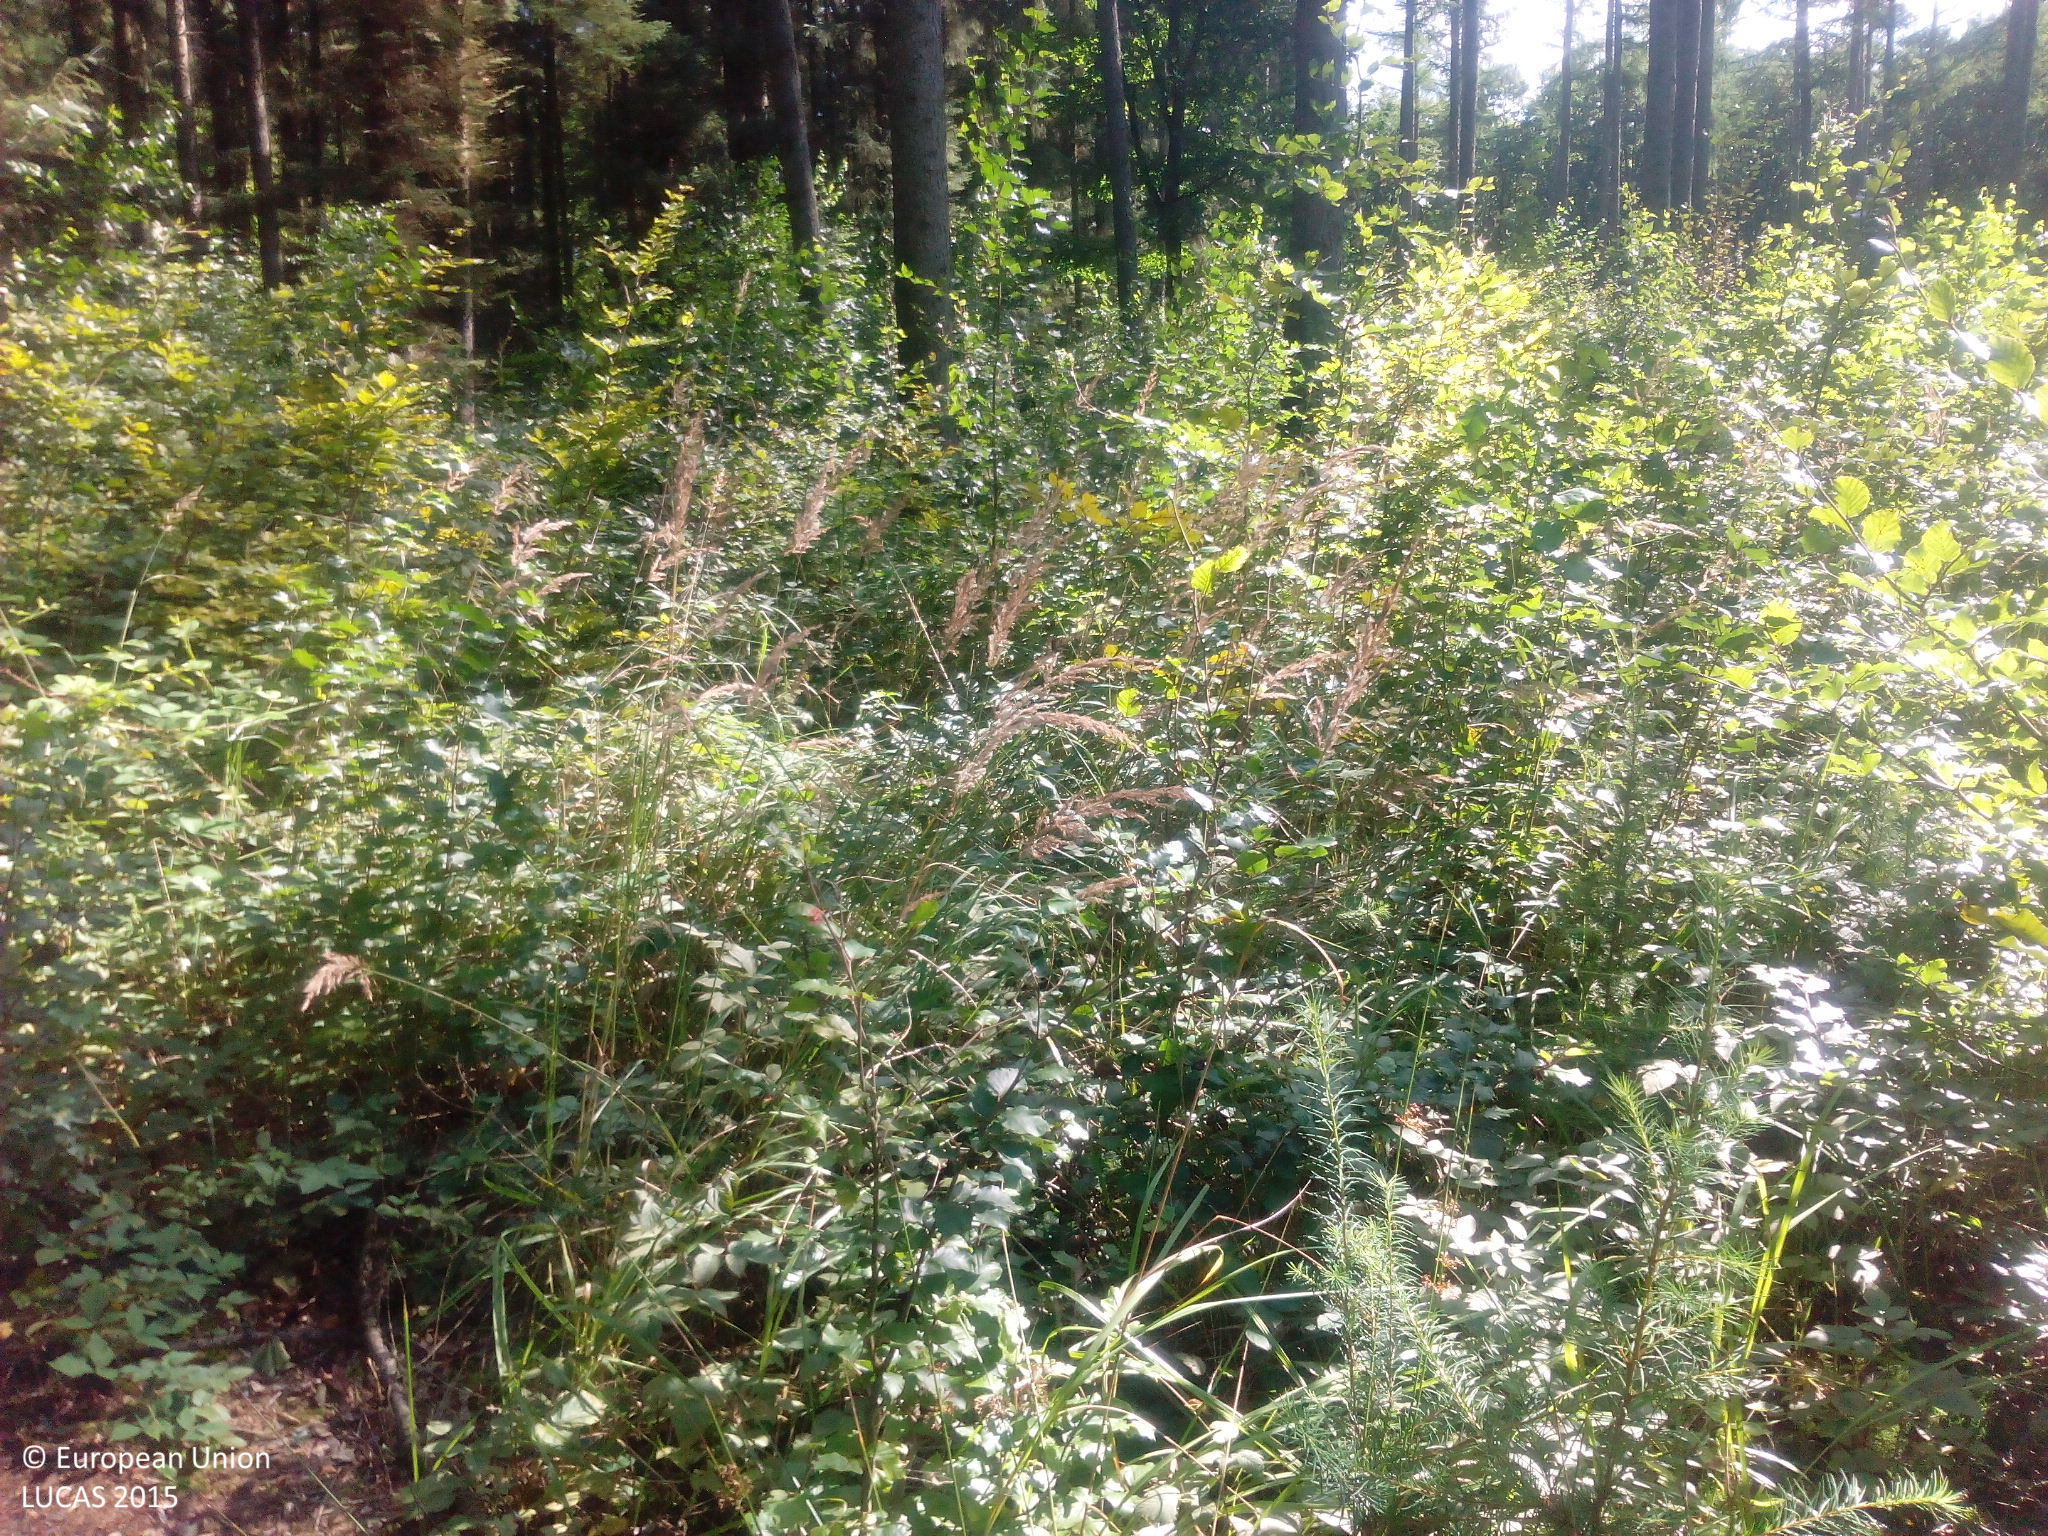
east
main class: Woodland
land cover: Other mixed woodland
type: hemiboreal forest and nemoral coniferous forest and mixed broadleaved-coniferous forest
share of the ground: > 75 %
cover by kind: coniferous forest trees 70 %, broadleaved forest trees 25 %, shrubs 5 %
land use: Forestry
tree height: > 5 m
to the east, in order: Other mixed woodland; Other fruit trees and berries; Other mixed woodland
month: September
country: DE
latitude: 54.1171
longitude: 12.3091
